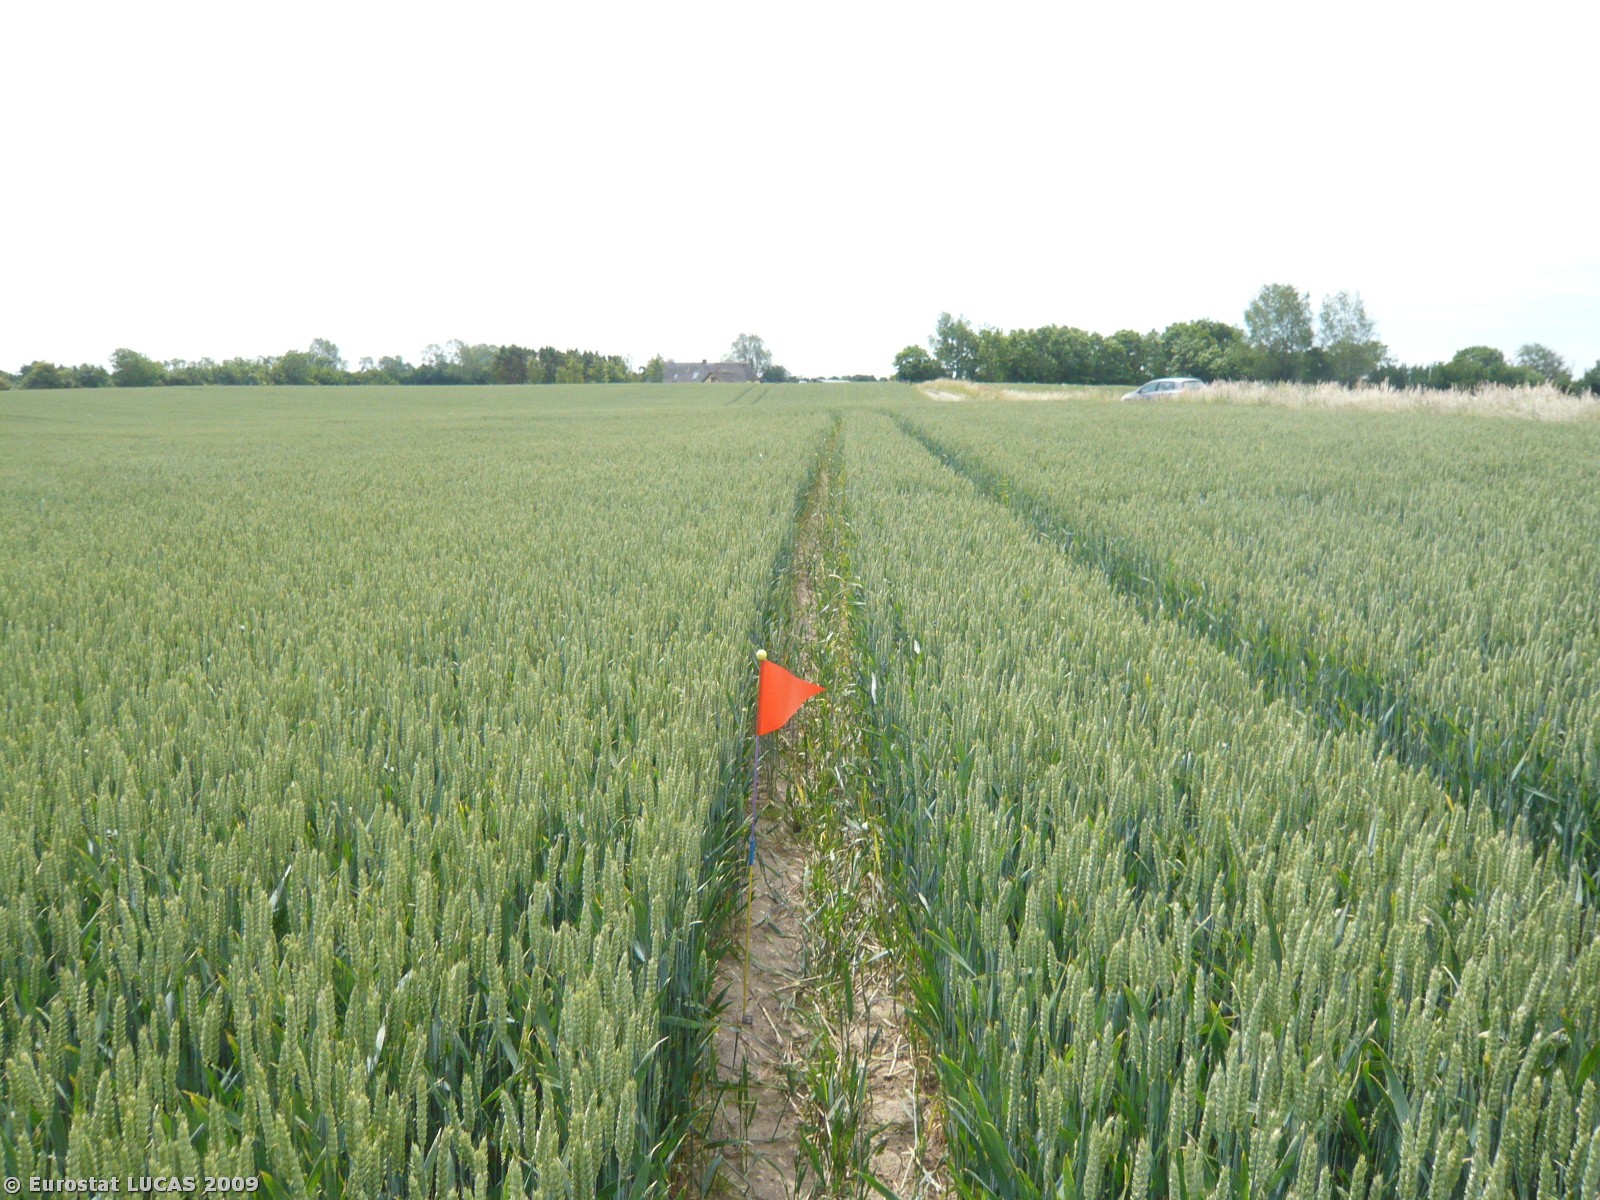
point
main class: Cropland
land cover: Common wheat
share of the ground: > 75 %
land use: Agriculture (excluding fallow land and kitchen gardens)
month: June
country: DK
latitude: 55.1968
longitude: 10.7691
